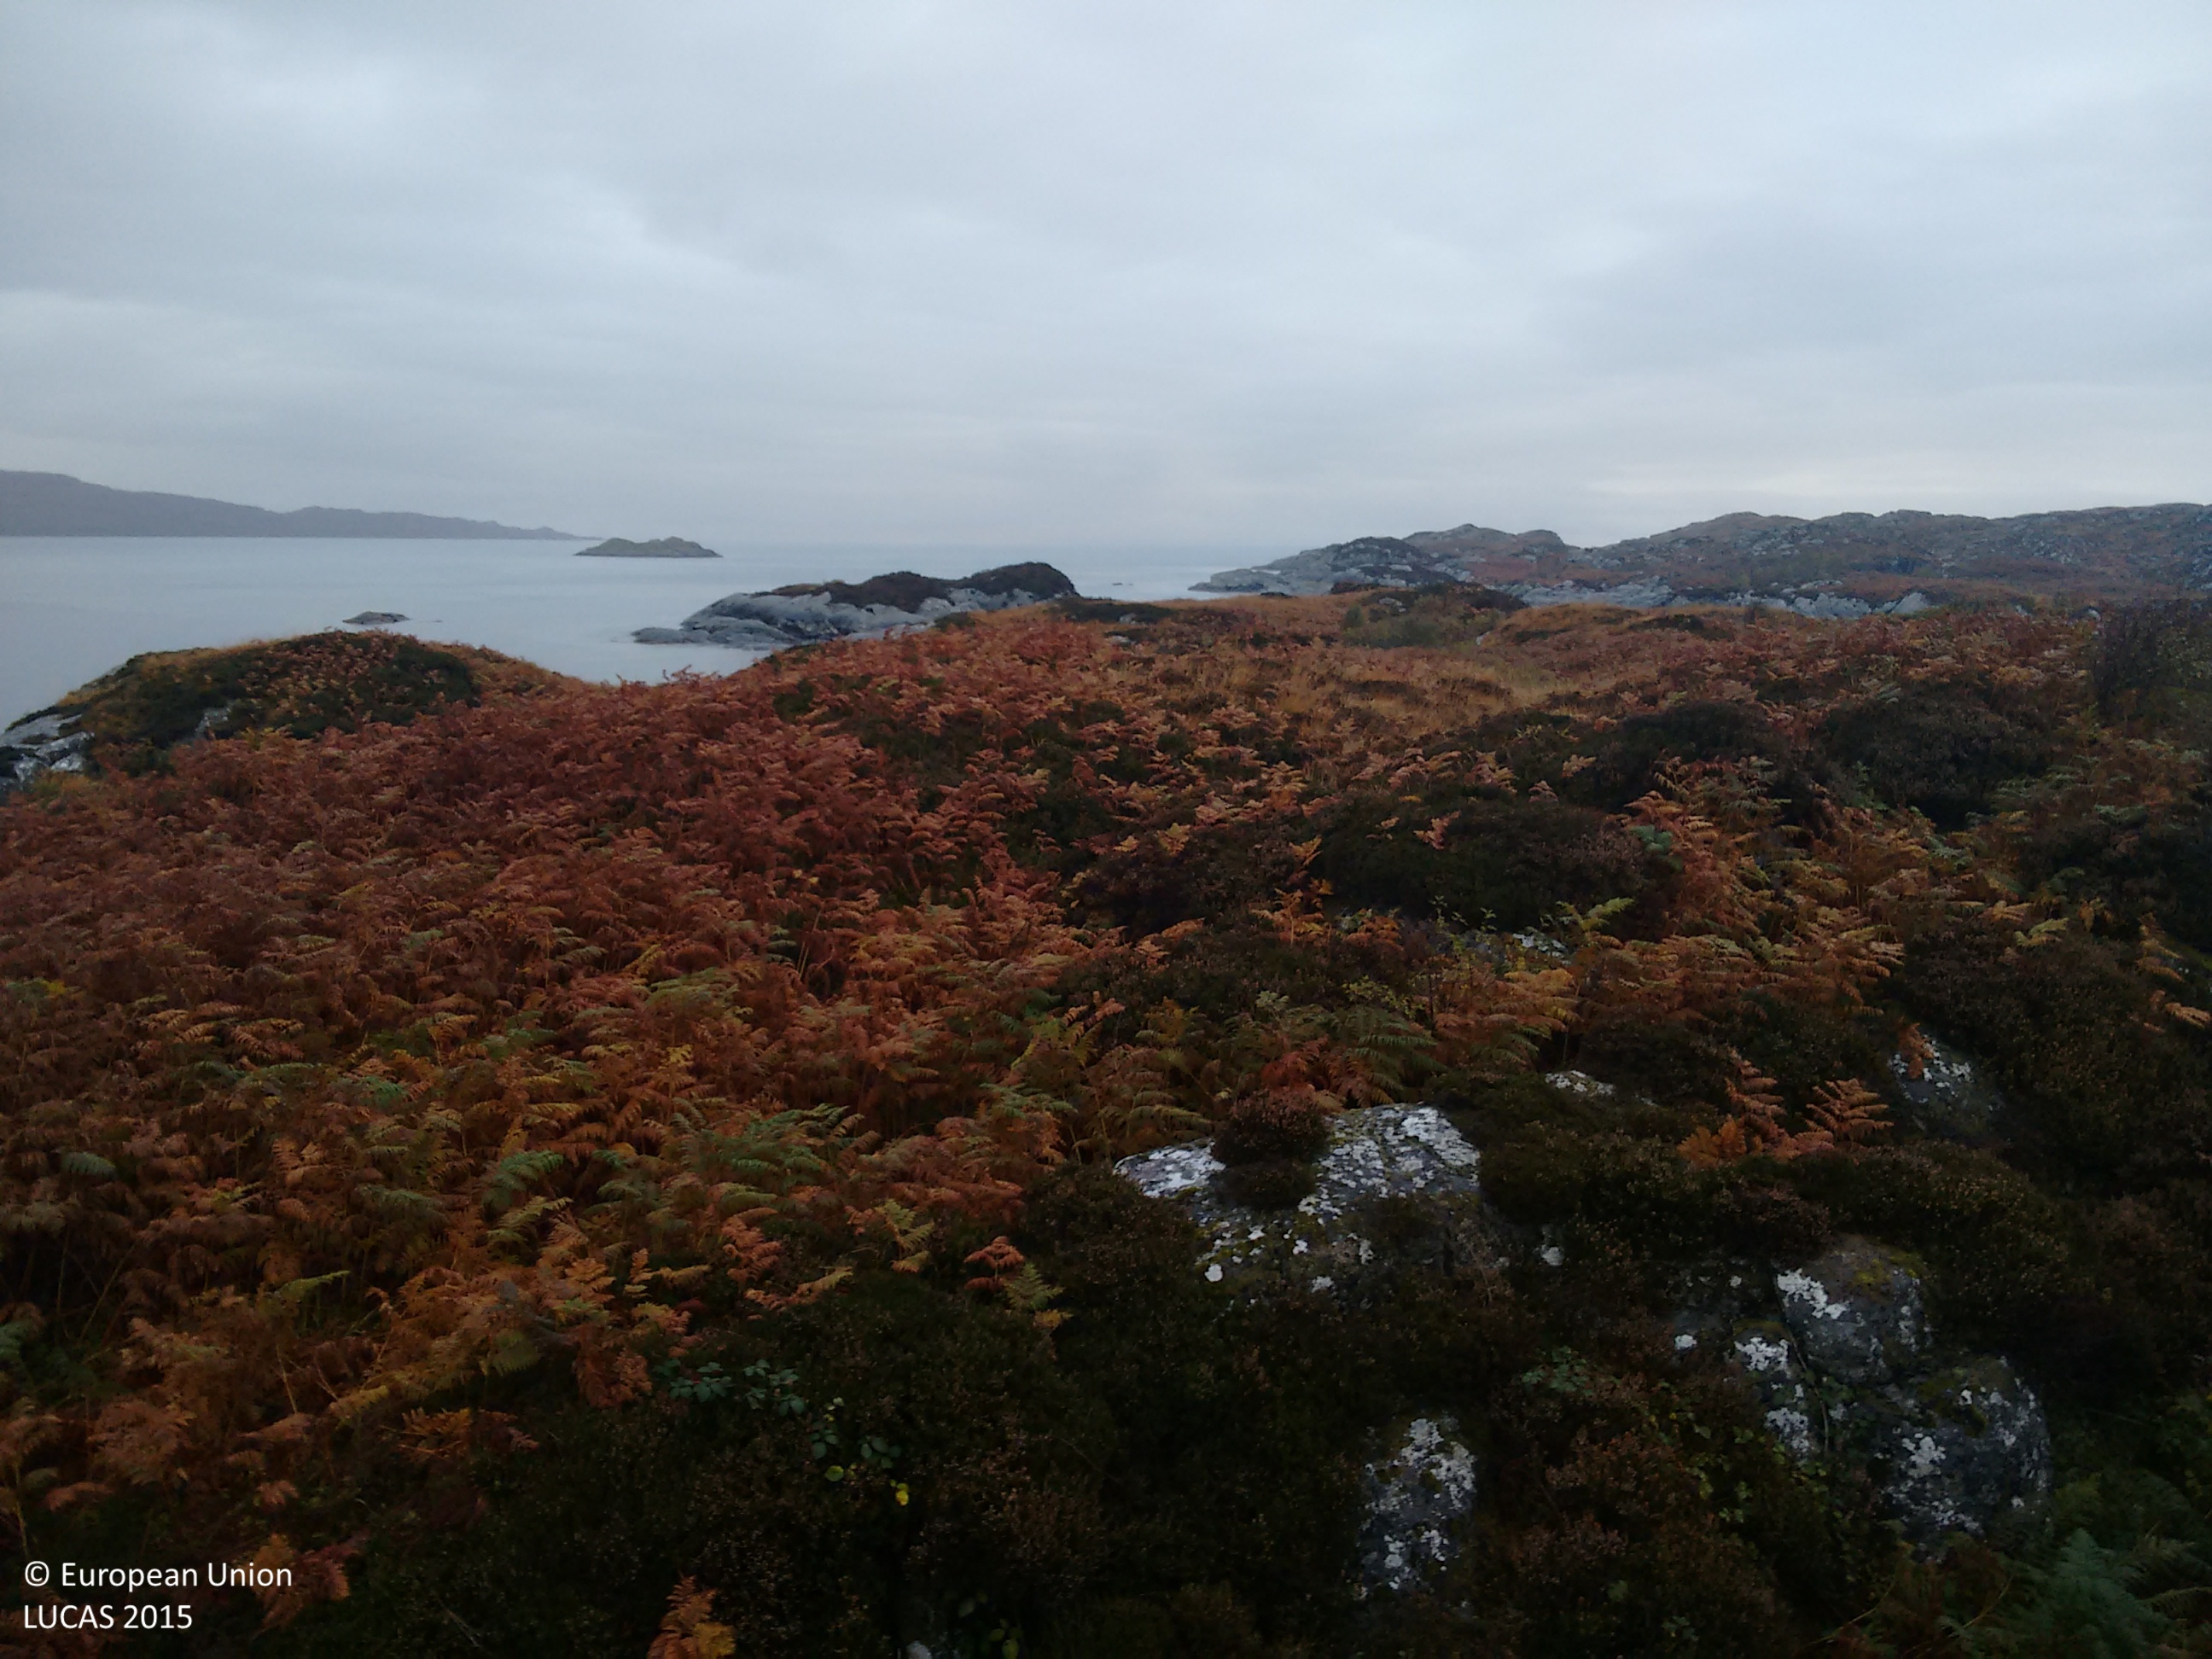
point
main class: Shrubland
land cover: Shrubland without tree cover
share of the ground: > 75 %
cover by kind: shrubs 50 %, herbaceous plants 30 %, consolidated bare surface 20 %
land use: Amenities, museums, leisure
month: October
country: GB
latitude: 56.7690
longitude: -5.8851
